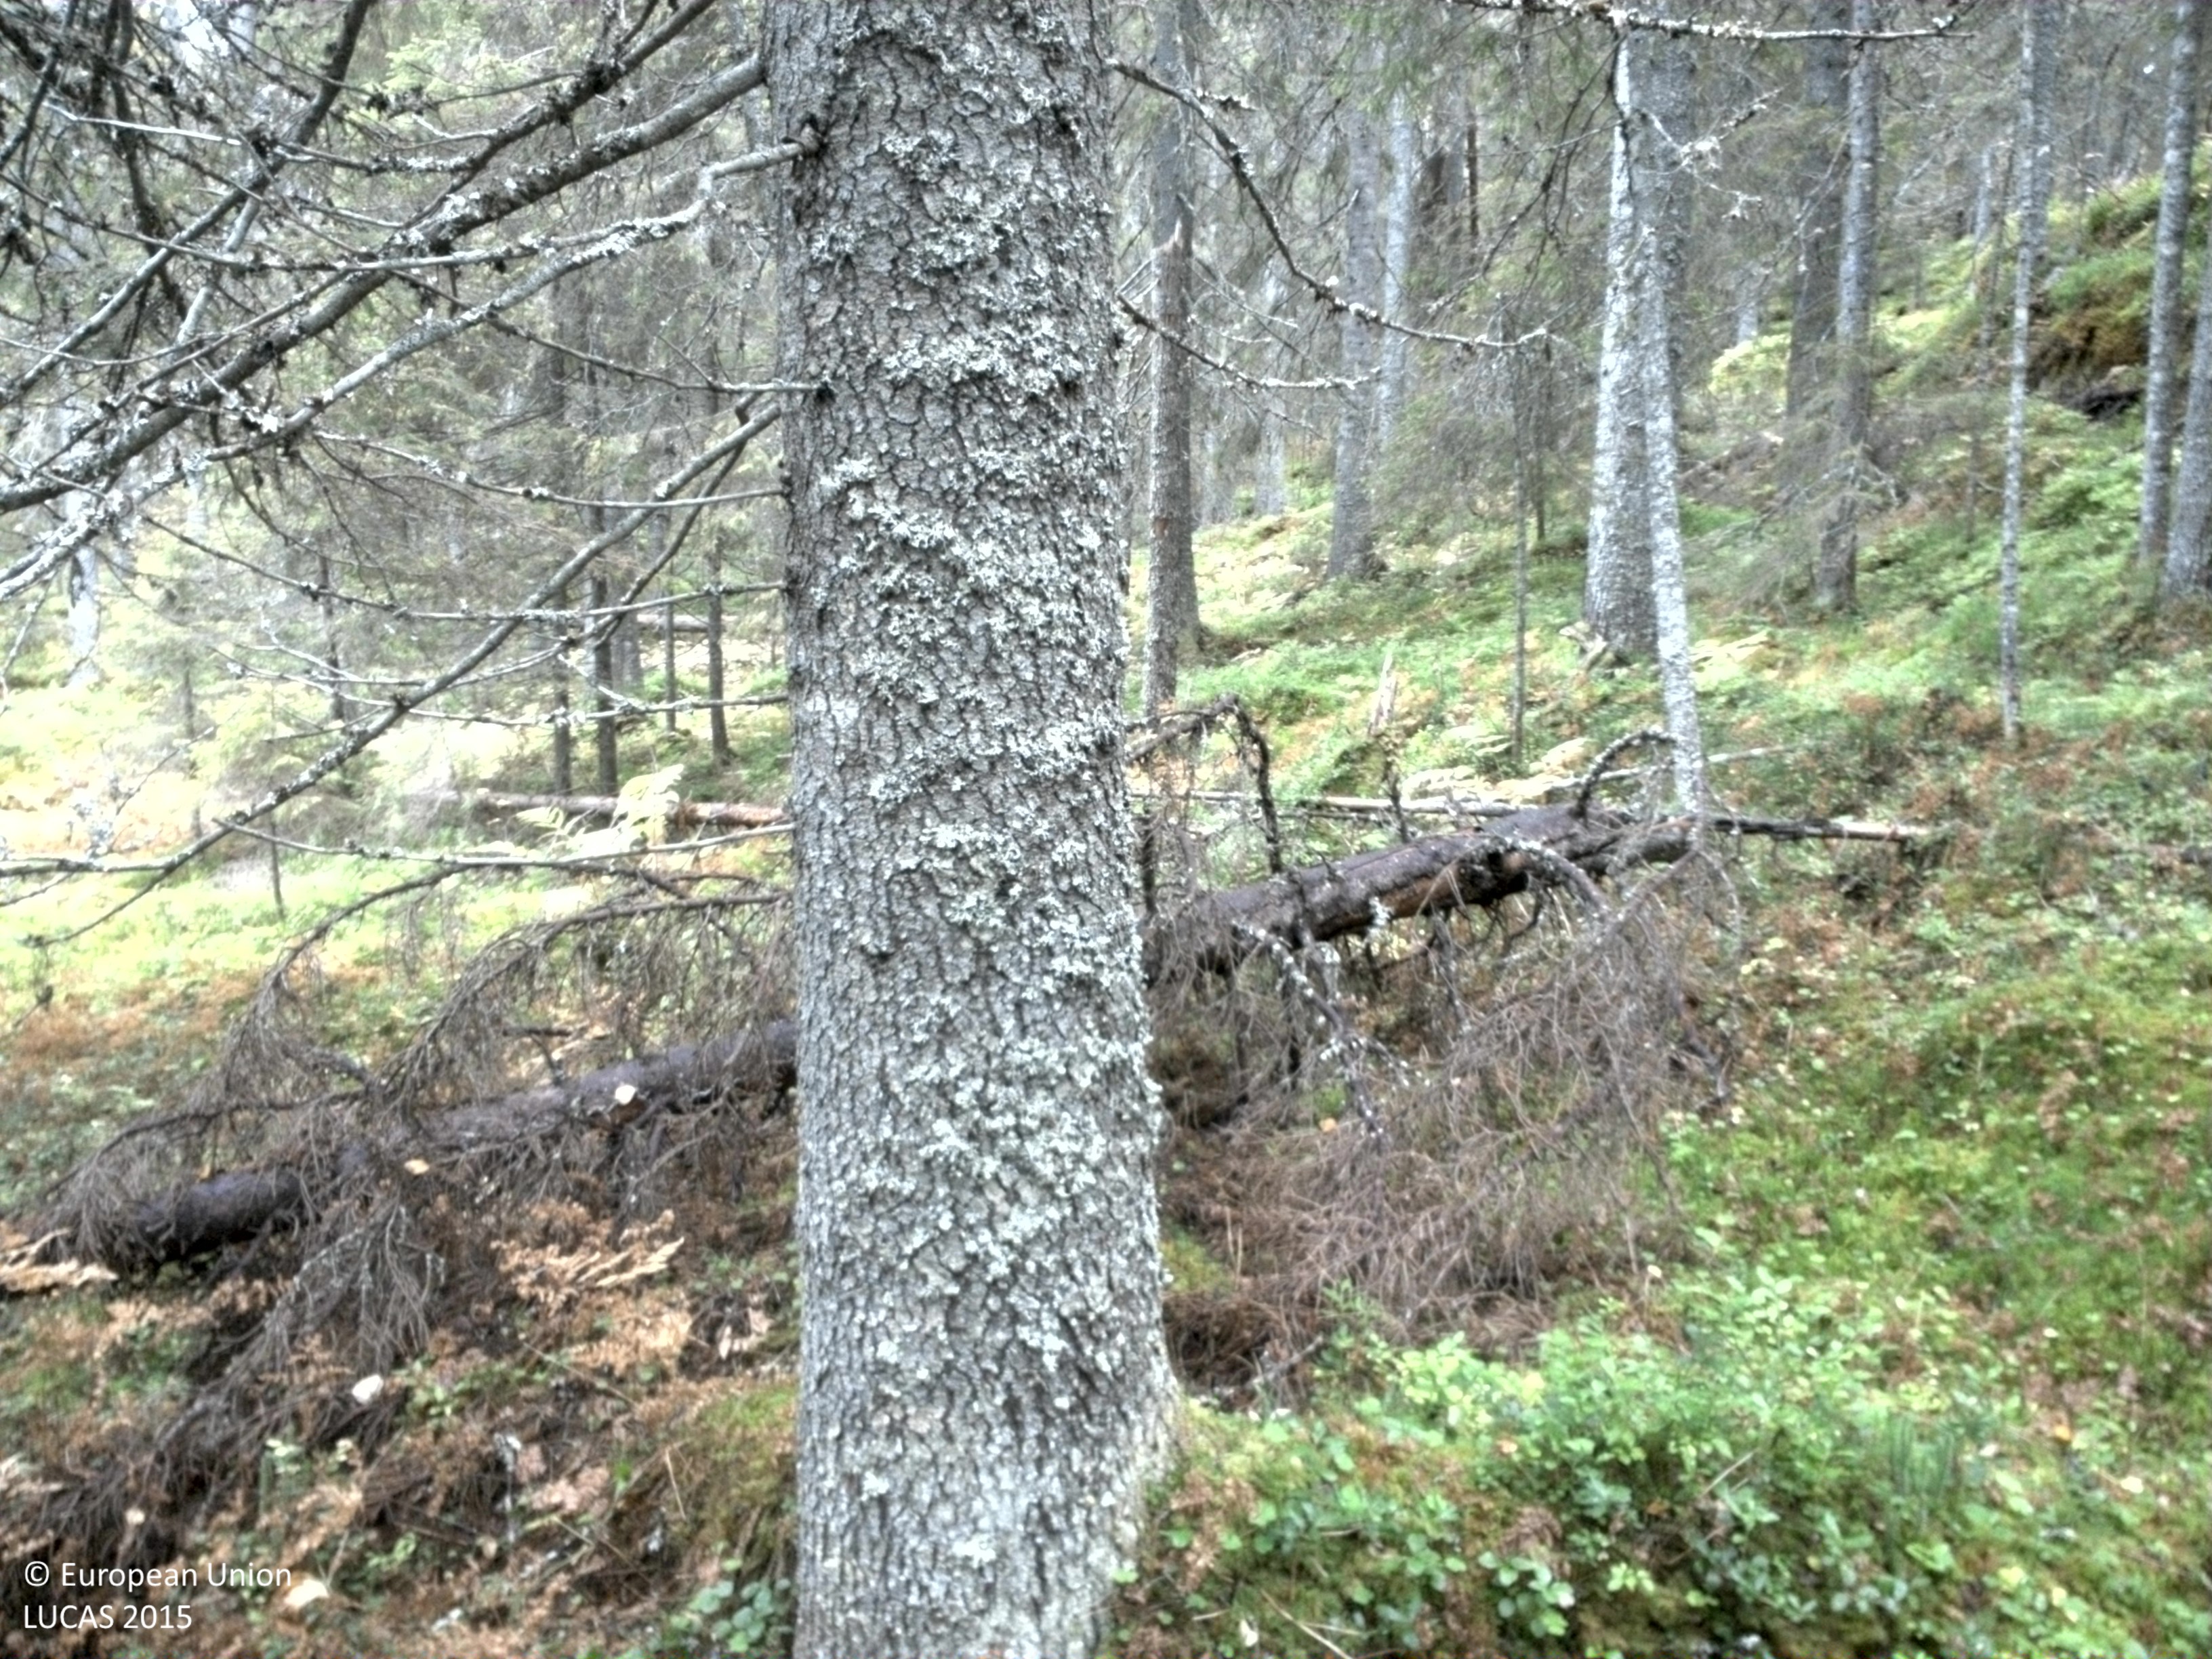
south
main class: Woodland
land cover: Spruce dominated coniferous woodland
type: boreal forest
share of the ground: 50 - 75 %
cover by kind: coniferous forest trees 60 %, shrubs 15 %, herbaceous plants 15 %, lichens and mosses 10 %
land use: Forestry
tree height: > 5 m
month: September
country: SE
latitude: 64.8784
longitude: 17.7966
